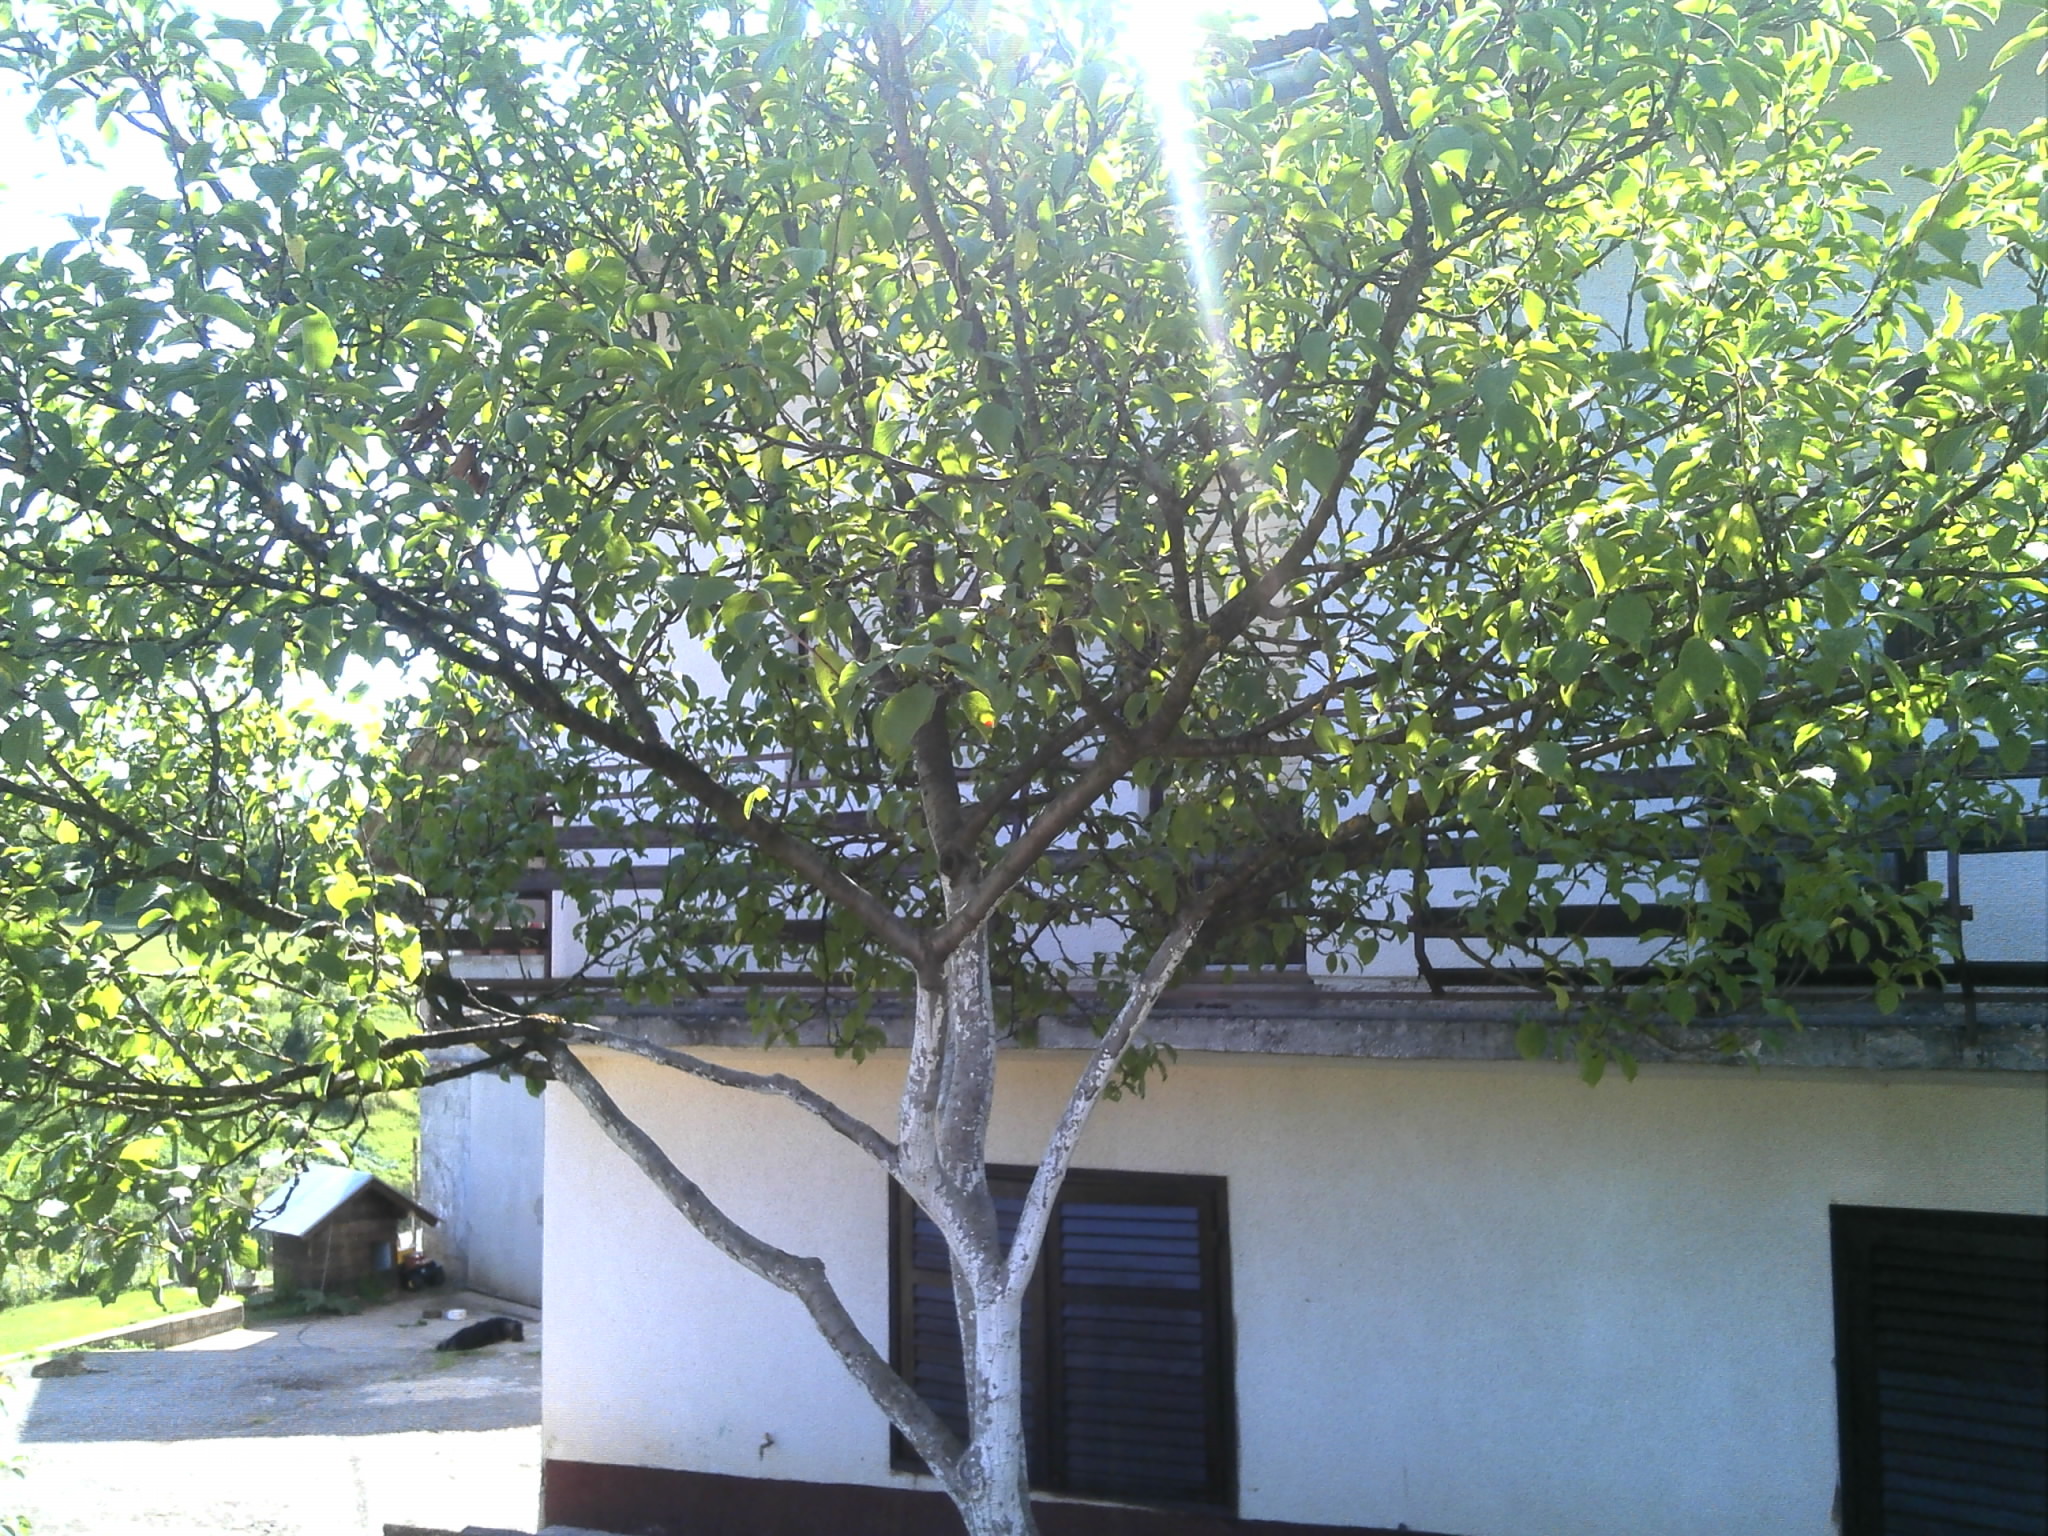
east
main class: Cropland
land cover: Other fruit trees and berries
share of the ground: 10 - 25 %
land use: Kitchen garden
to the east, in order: Other fruit trees and berries; Artificial constructions in urban areas; Fences; Electric lines; Grassland without tree/shrub cover; Electric lines; Grassland without tree/shrub cover; Inland fresh water bodies; Grassland without tree/shrub cover; Electric lines; Grassland without tree/shrub cover; Broadleaved woodland; Paved roads, cycling and walking lanes; Single bushes/trees; Artificial constructions in urban areas
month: July
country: HR
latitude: 44.8720
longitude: 15.1712
